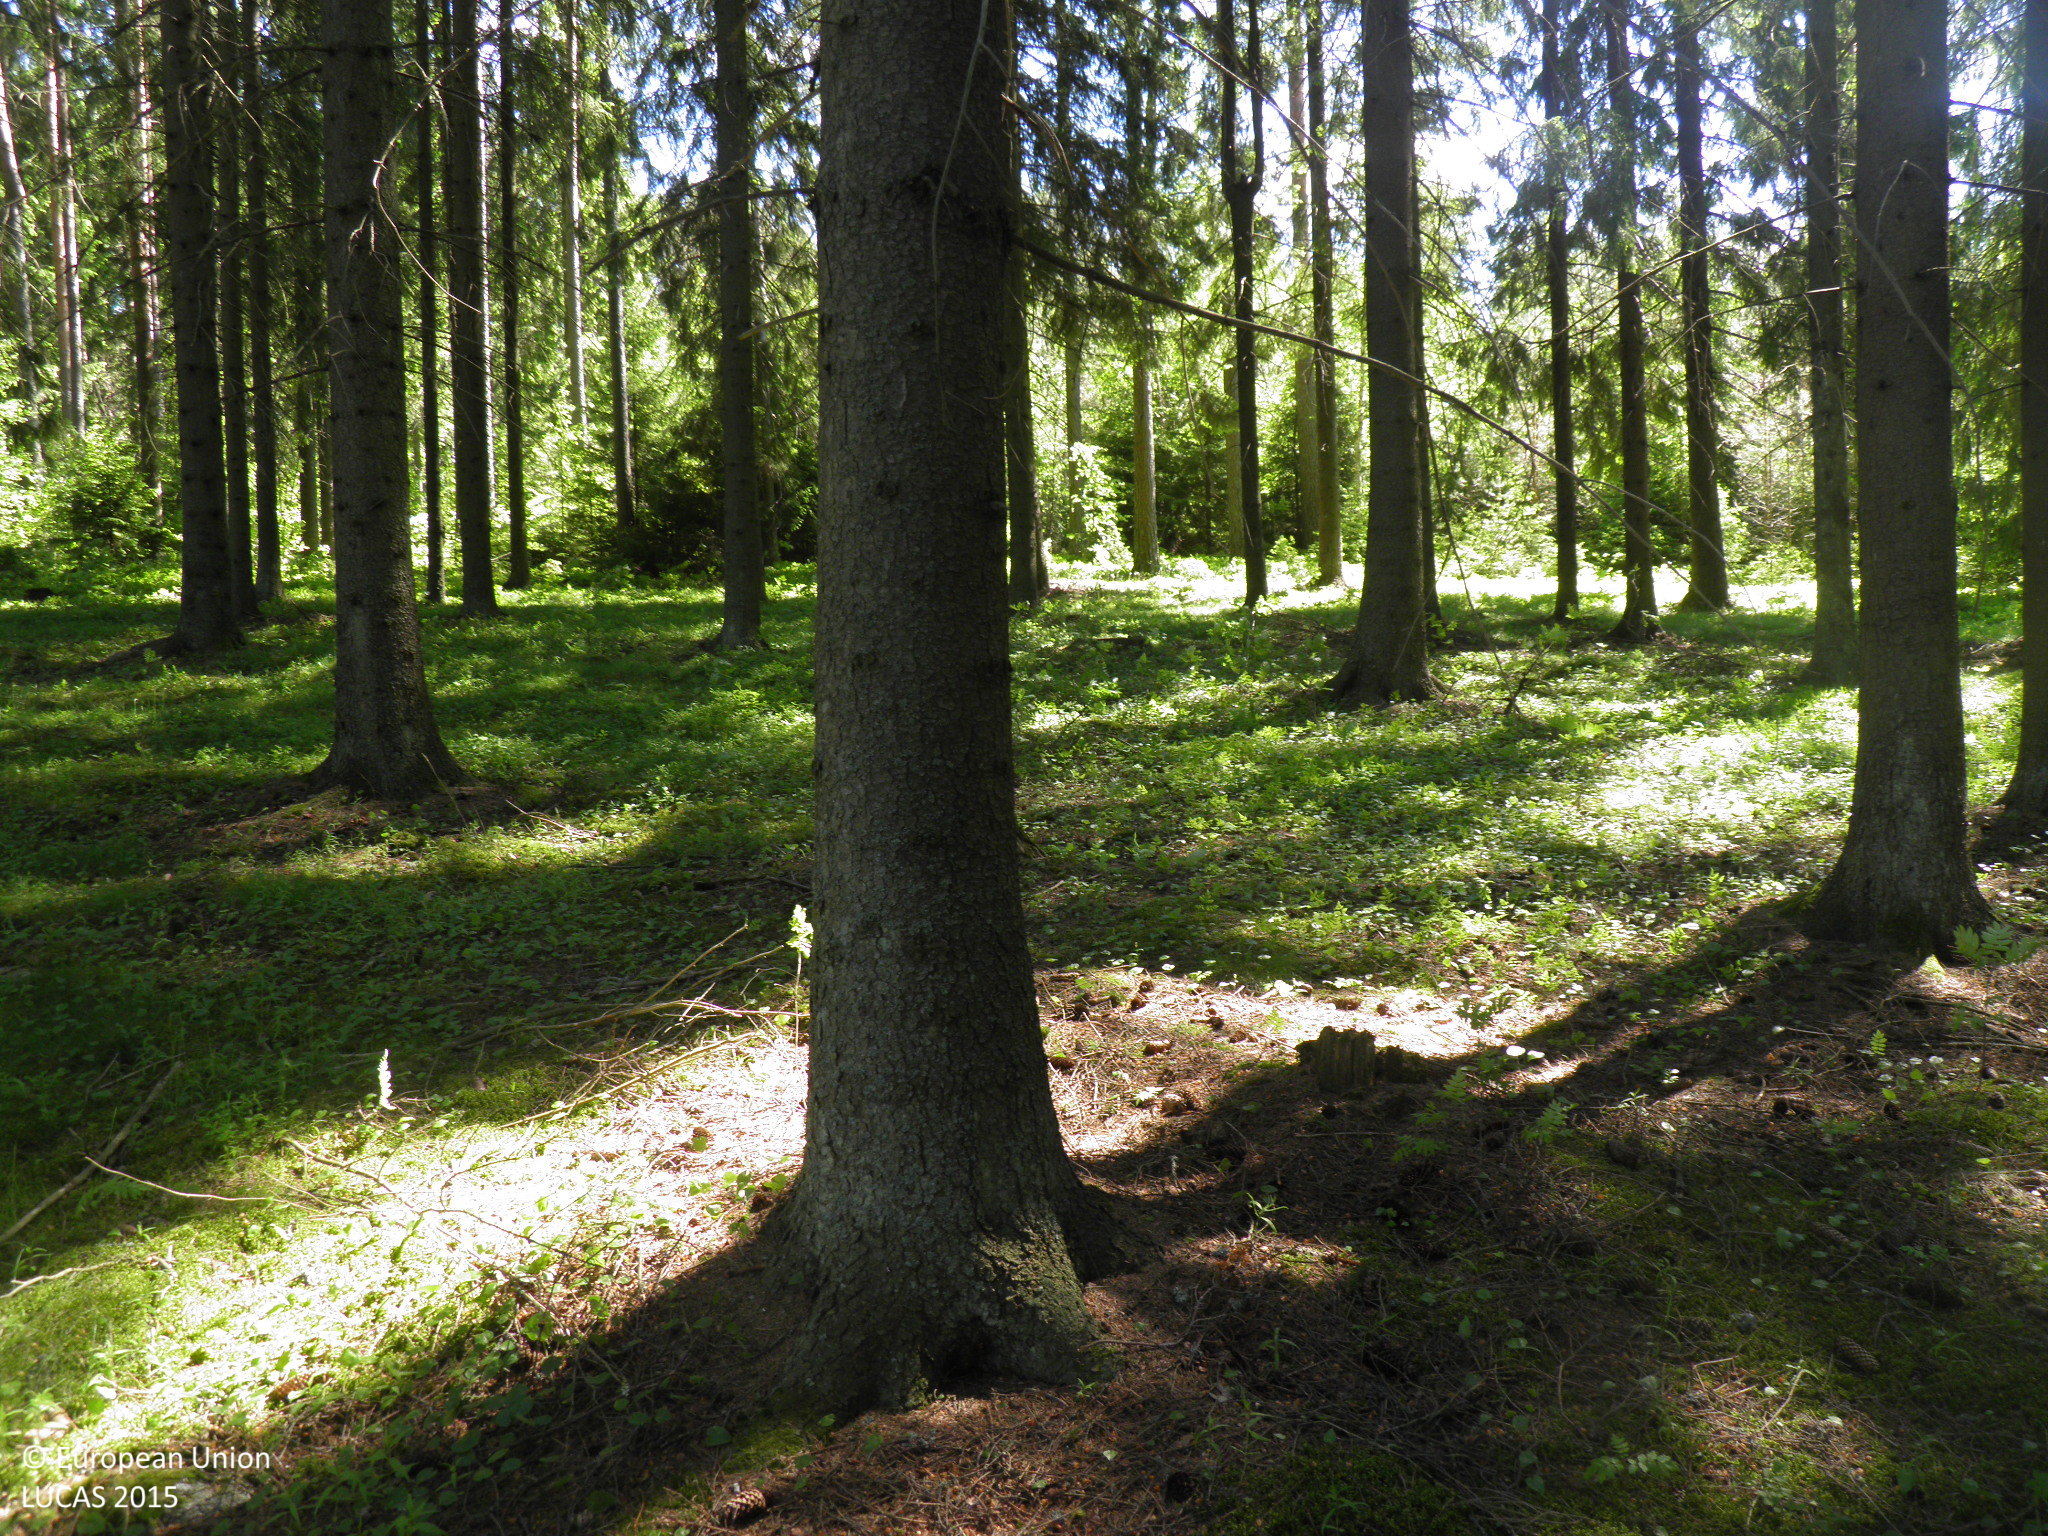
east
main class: Woodland
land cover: Spruce dominated coniferous woodland
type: boreal forest
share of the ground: > 75 %
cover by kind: coniferous forest trees 85 %, shrubs 5 %, herbaceous plants 5 %, unconsolidated bare surface 5 %
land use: Forestry
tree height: > 5 m
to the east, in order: Spruce dominated coniferous woodland; Other coniferous woodland; Broadleaved woodland; Ditches and canals; Broadleaved woodland; Spruce dominated coniferous woodland
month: June
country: FI
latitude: 60.3666
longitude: 22.7486
